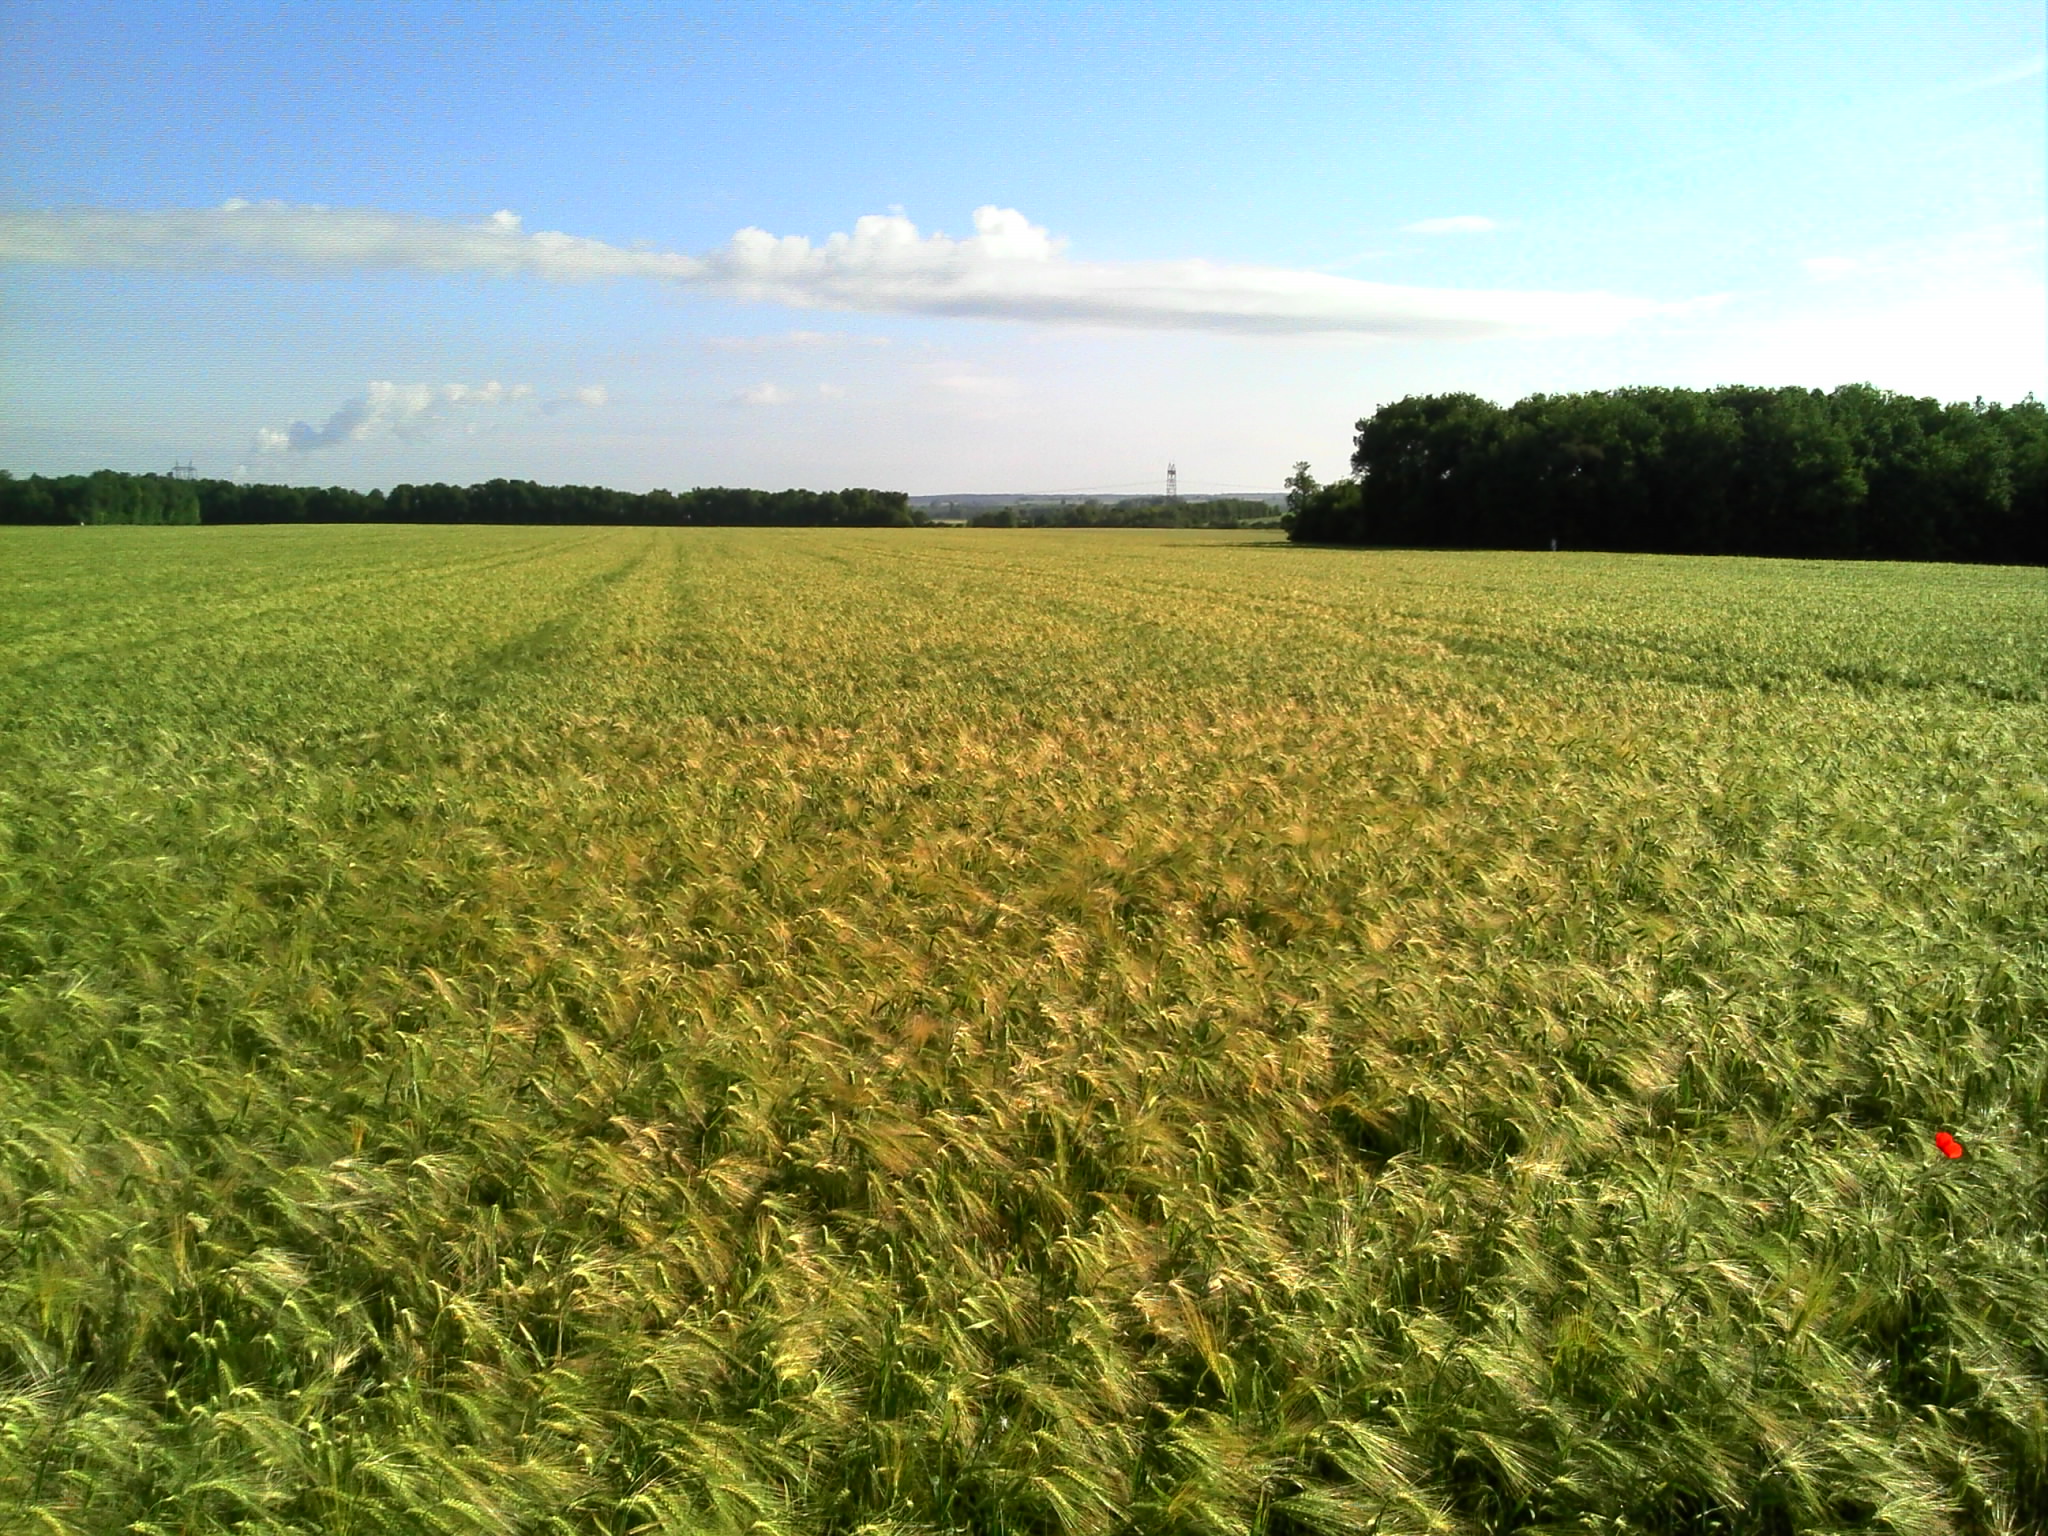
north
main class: Cropland
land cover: Rape and turnip rape
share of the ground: > 75 %
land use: Agriculture (excluding fallow land and kitchen gardens)
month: May
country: FR
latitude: 47.0580
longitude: 0.1692
